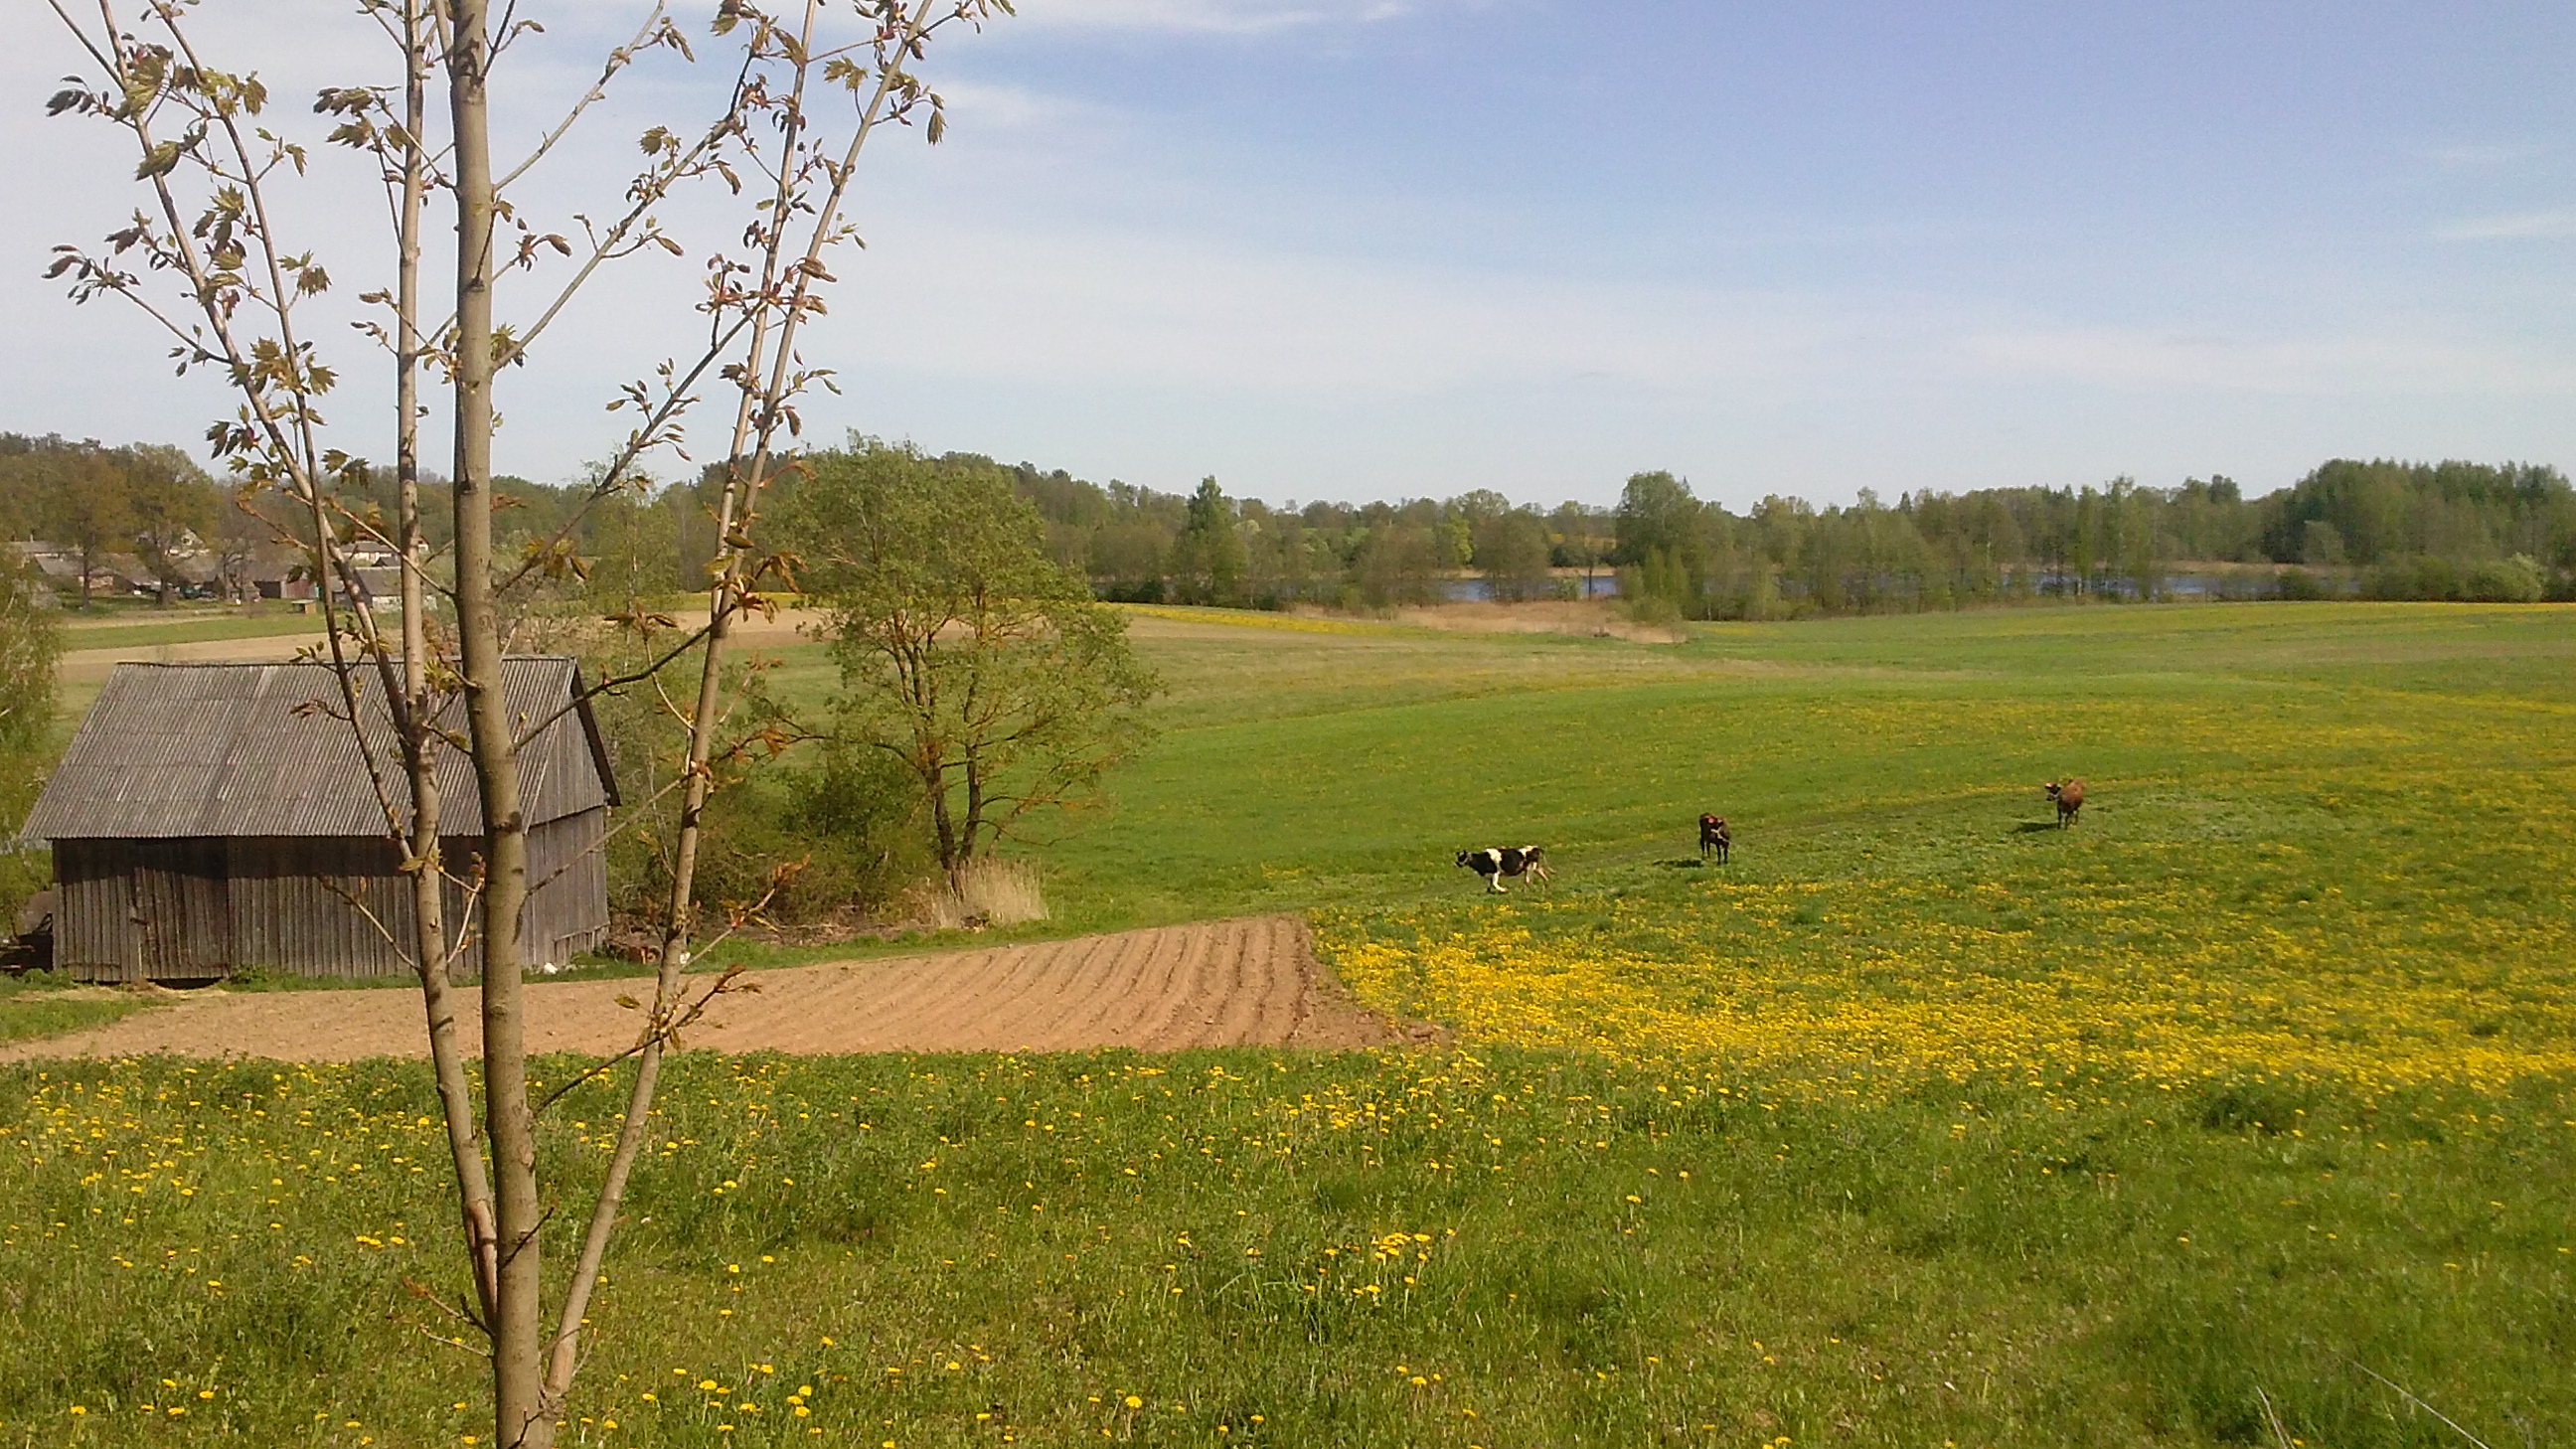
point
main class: Grassland
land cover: Grassland without tree/shrub cover
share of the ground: > 75 %
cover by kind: herbaceous plants 100 %
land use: Agriculture (excluding fallow land and kitchen gardens)
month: May
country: LV
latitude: 55.9712
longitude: 27.6020
